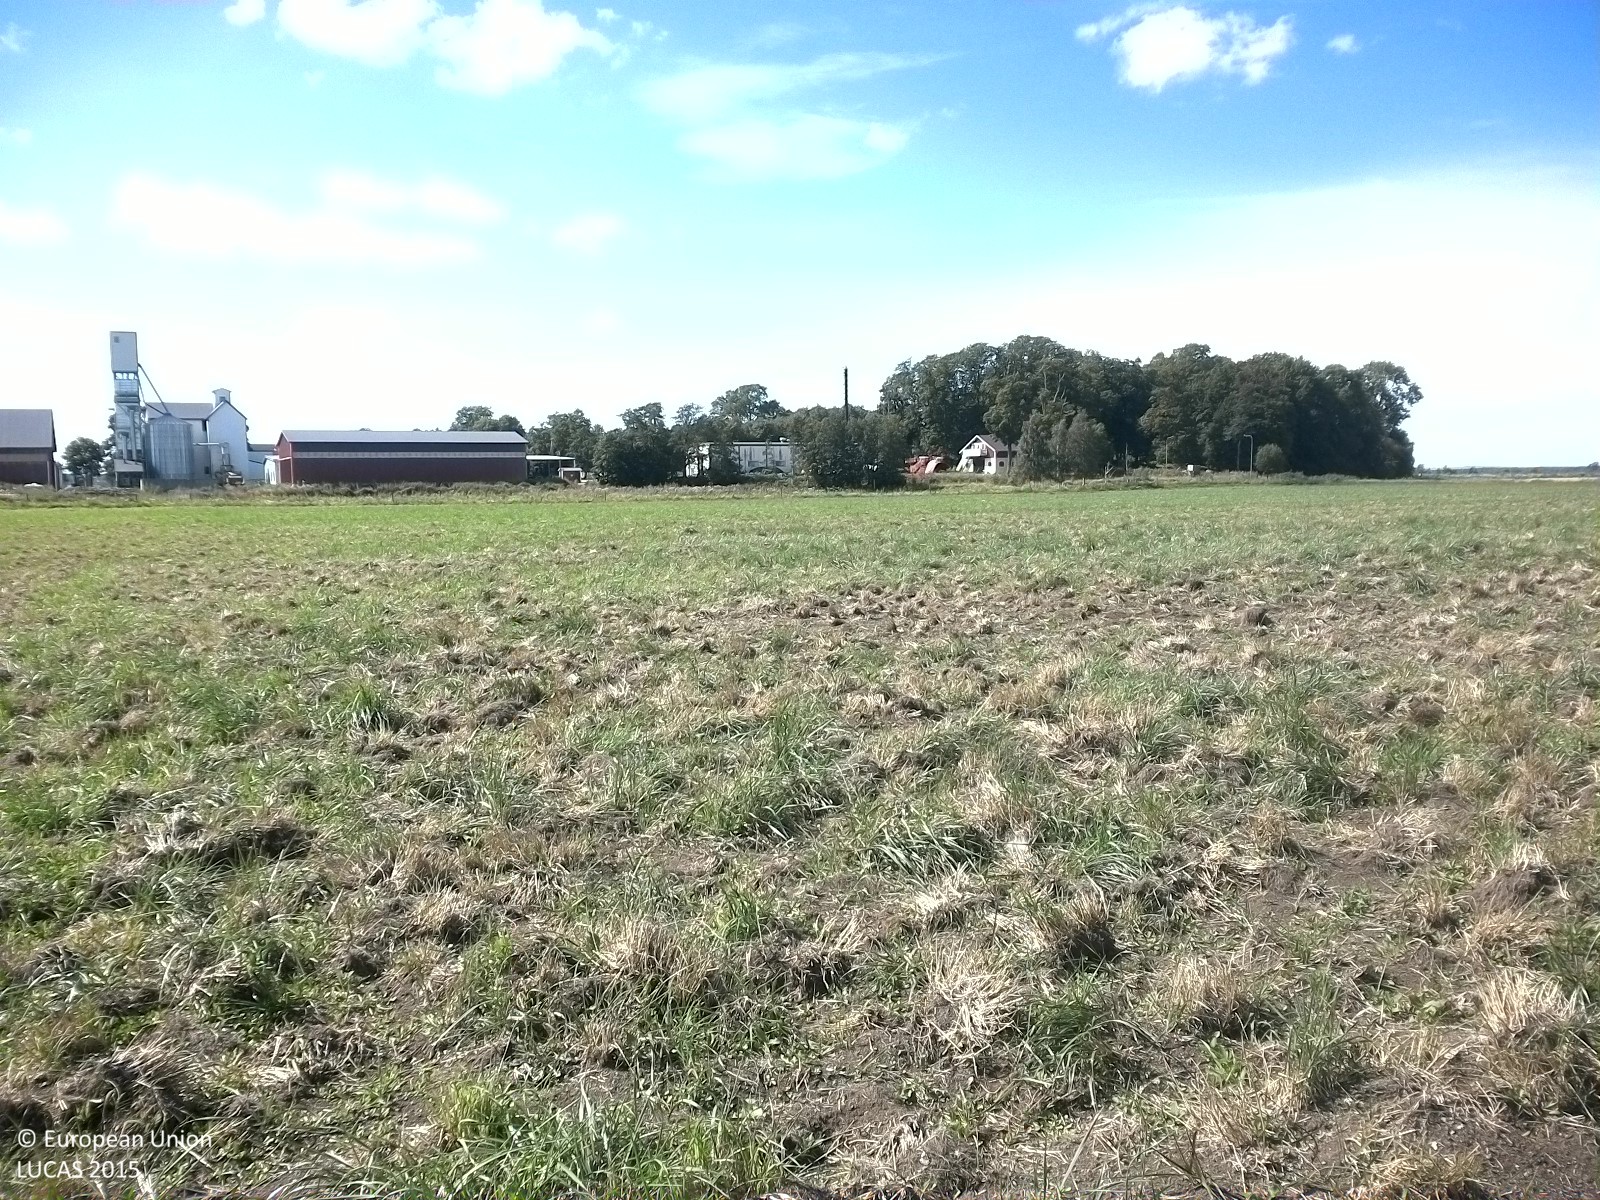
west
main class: Cropland
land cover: Temporary grasslands
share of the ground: > 75 %
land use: Agriculture (excluding fallow land and kitchen gardens)
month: August
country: SE
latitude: 59.1573
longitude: 15.3957
